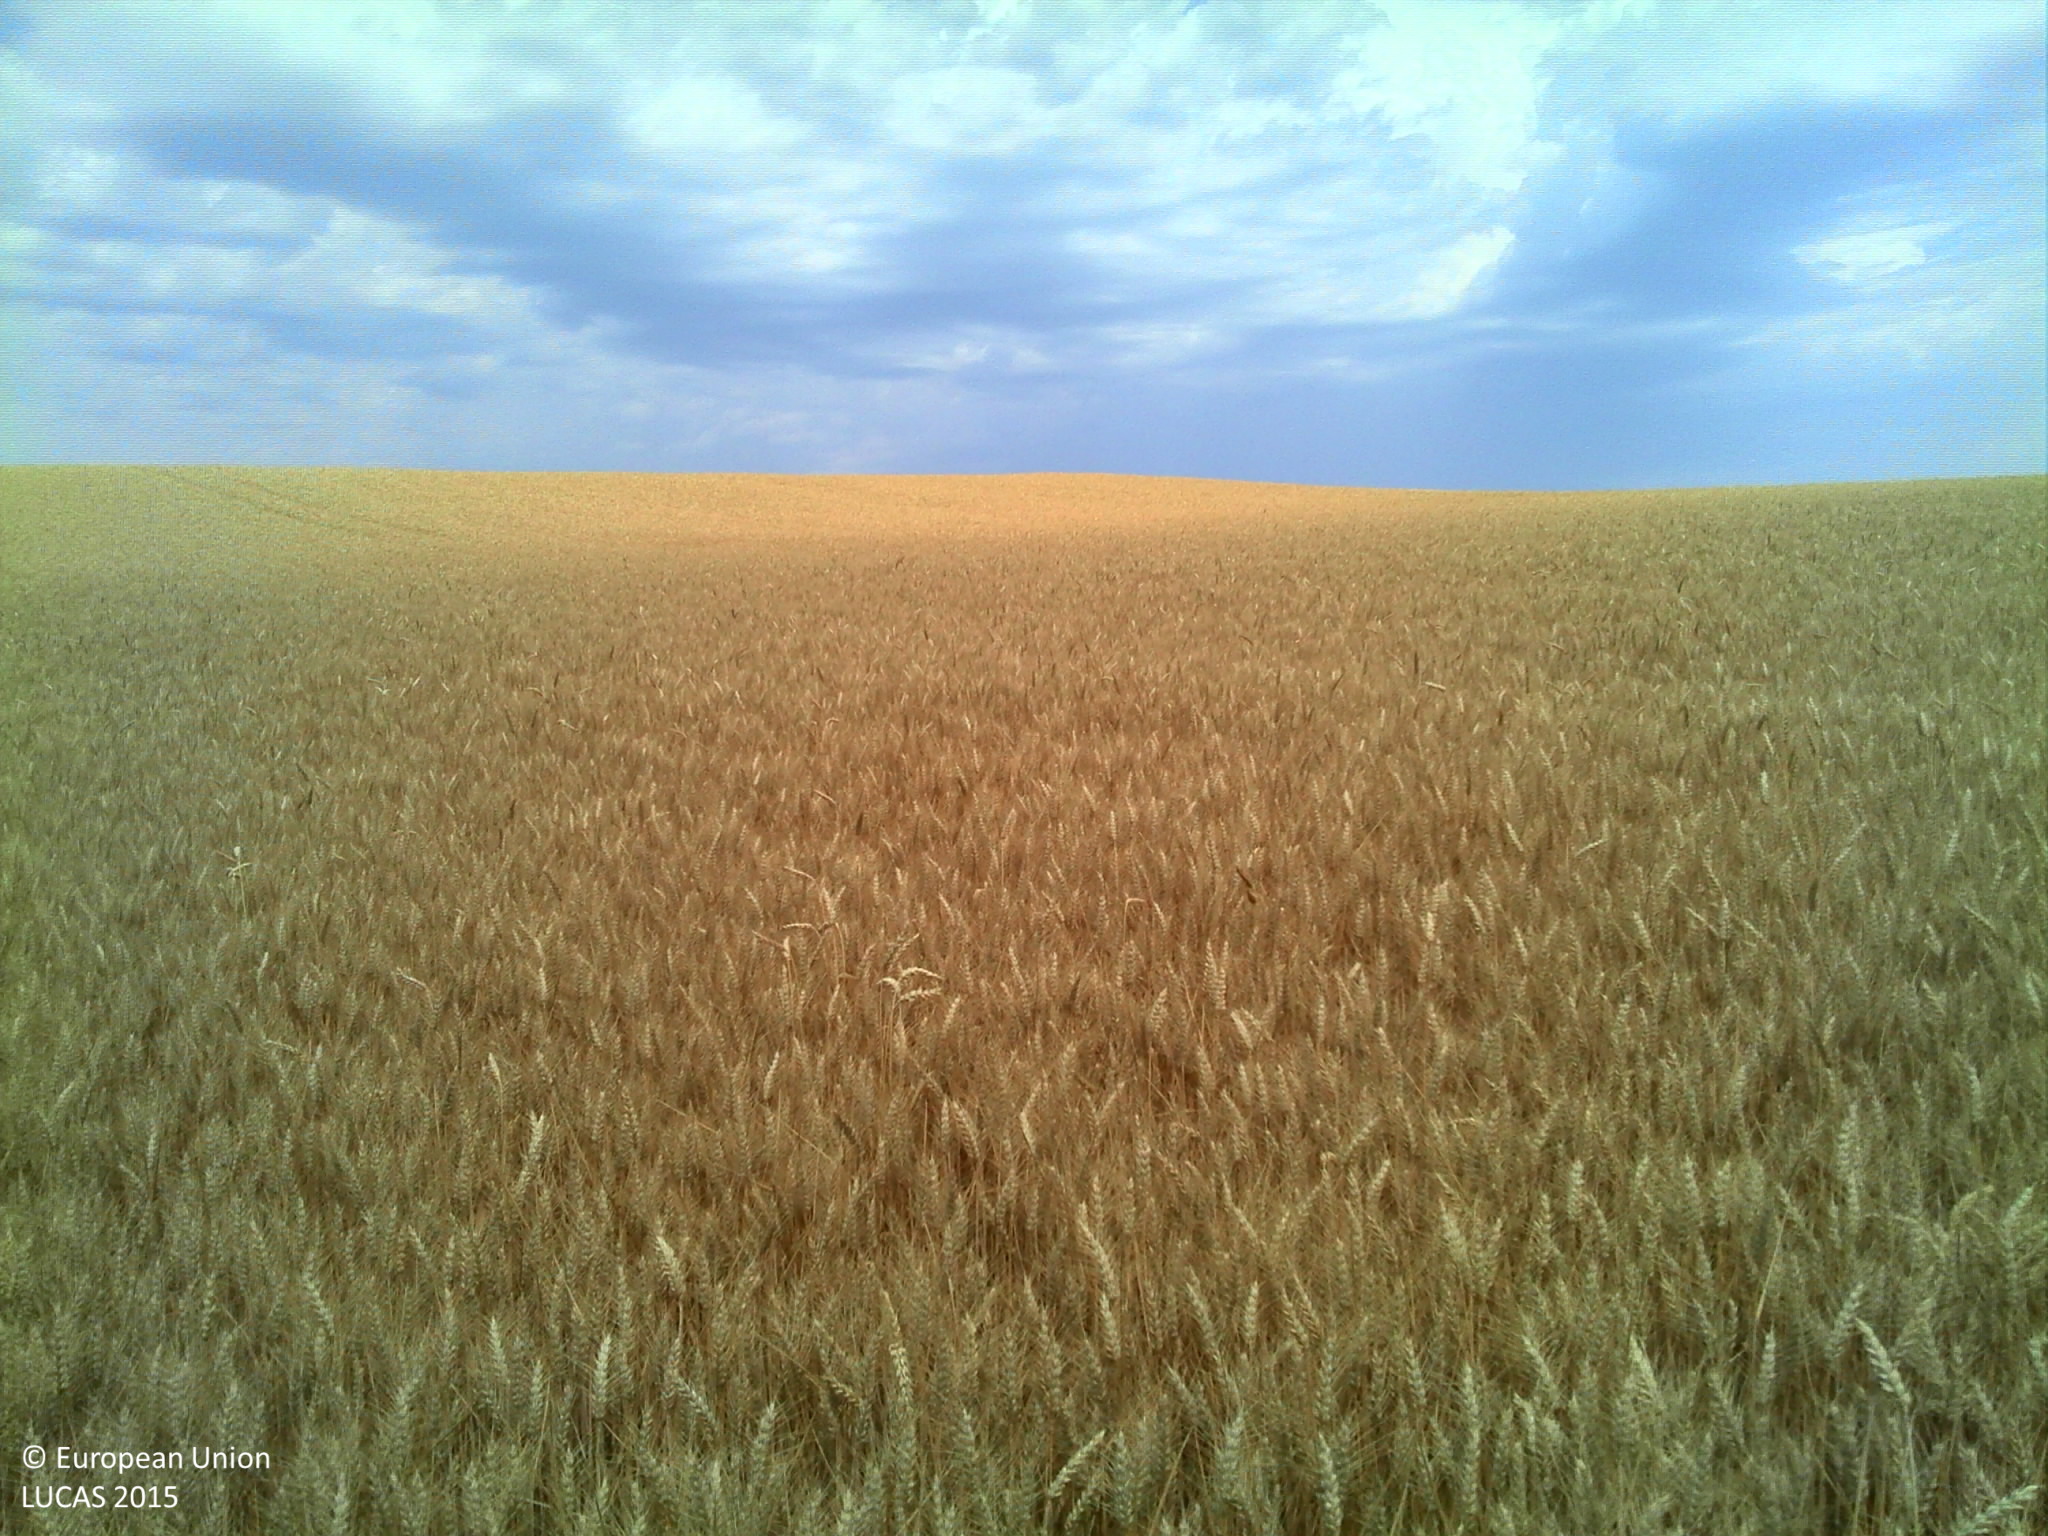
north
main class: Cropland
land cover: Durum wheat
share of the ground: > 75 %
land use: Agriculture (excluding fallow land and kitchen gardens)
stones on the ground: 10 - 25 %
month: July
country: FR
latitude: 47.2932
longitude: 3.5305
